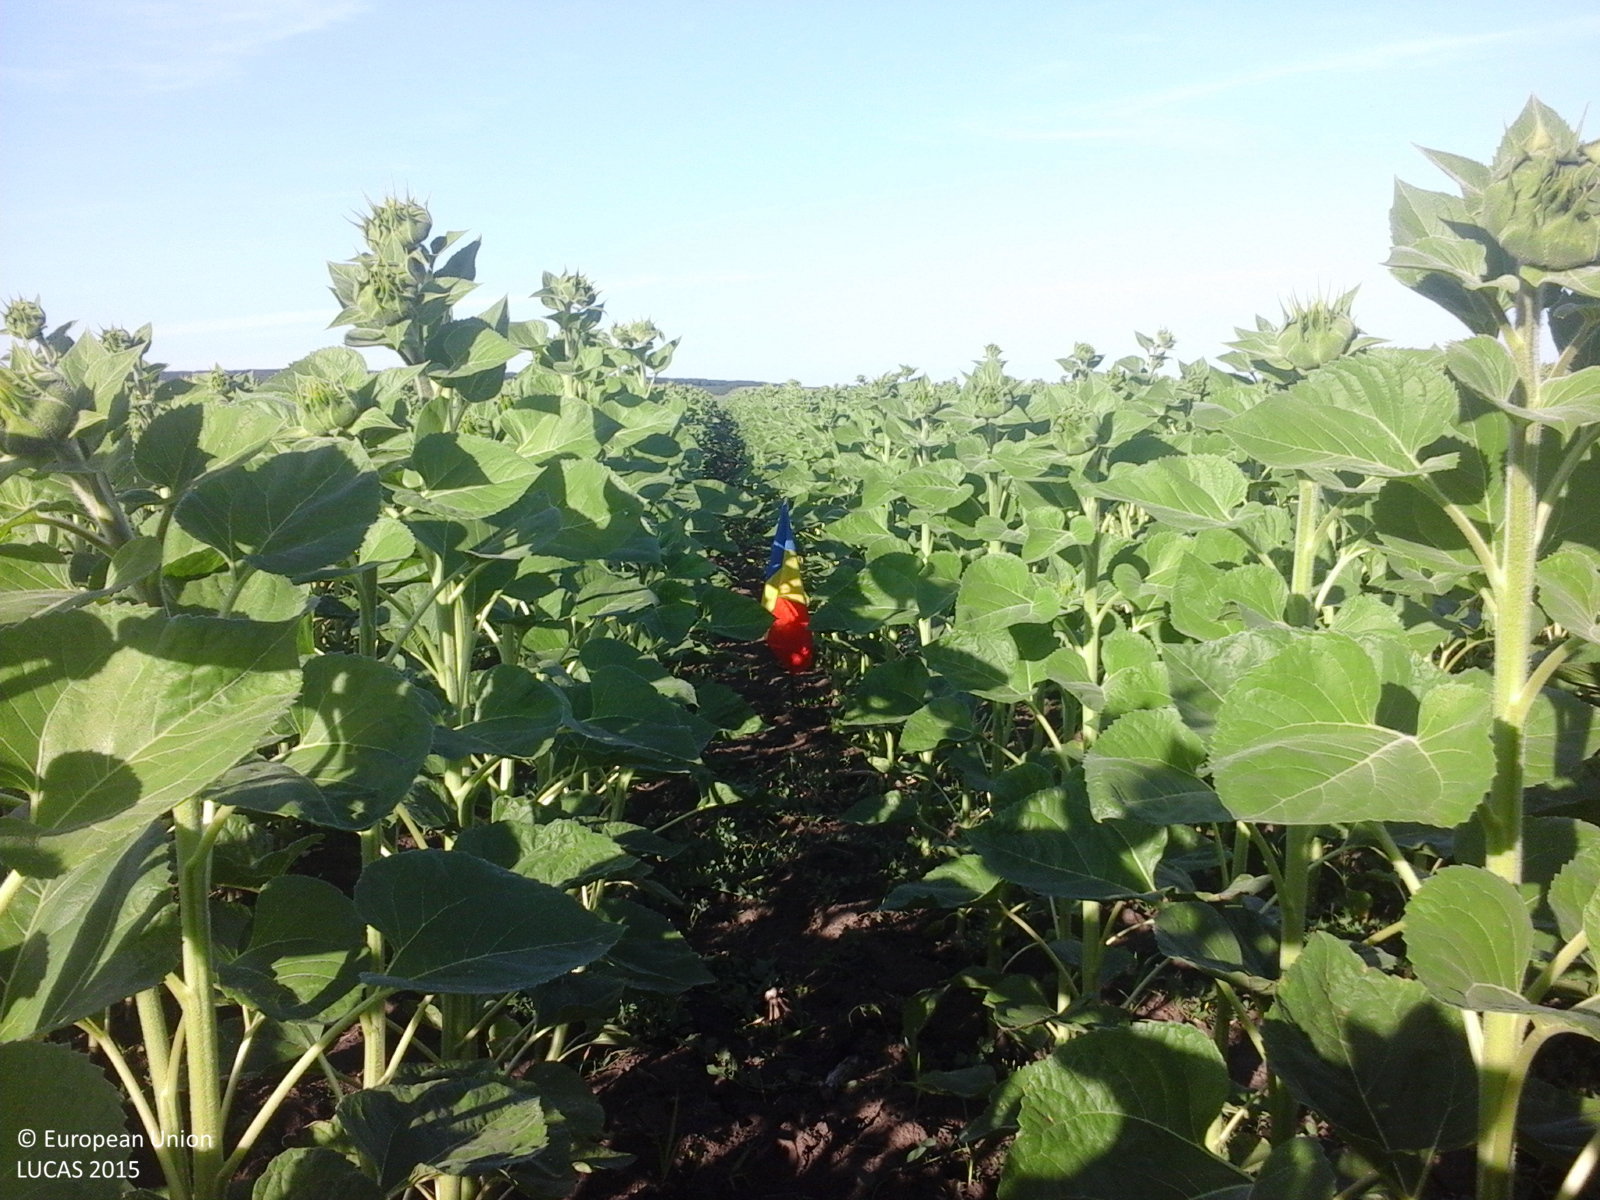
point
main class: Cropland
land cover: Sunflower
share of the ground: > 75 %
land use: Agriculture (excluding fallow land and kitchen gardens)
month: June
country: RO
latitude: 47.6114
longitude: 27.2047
